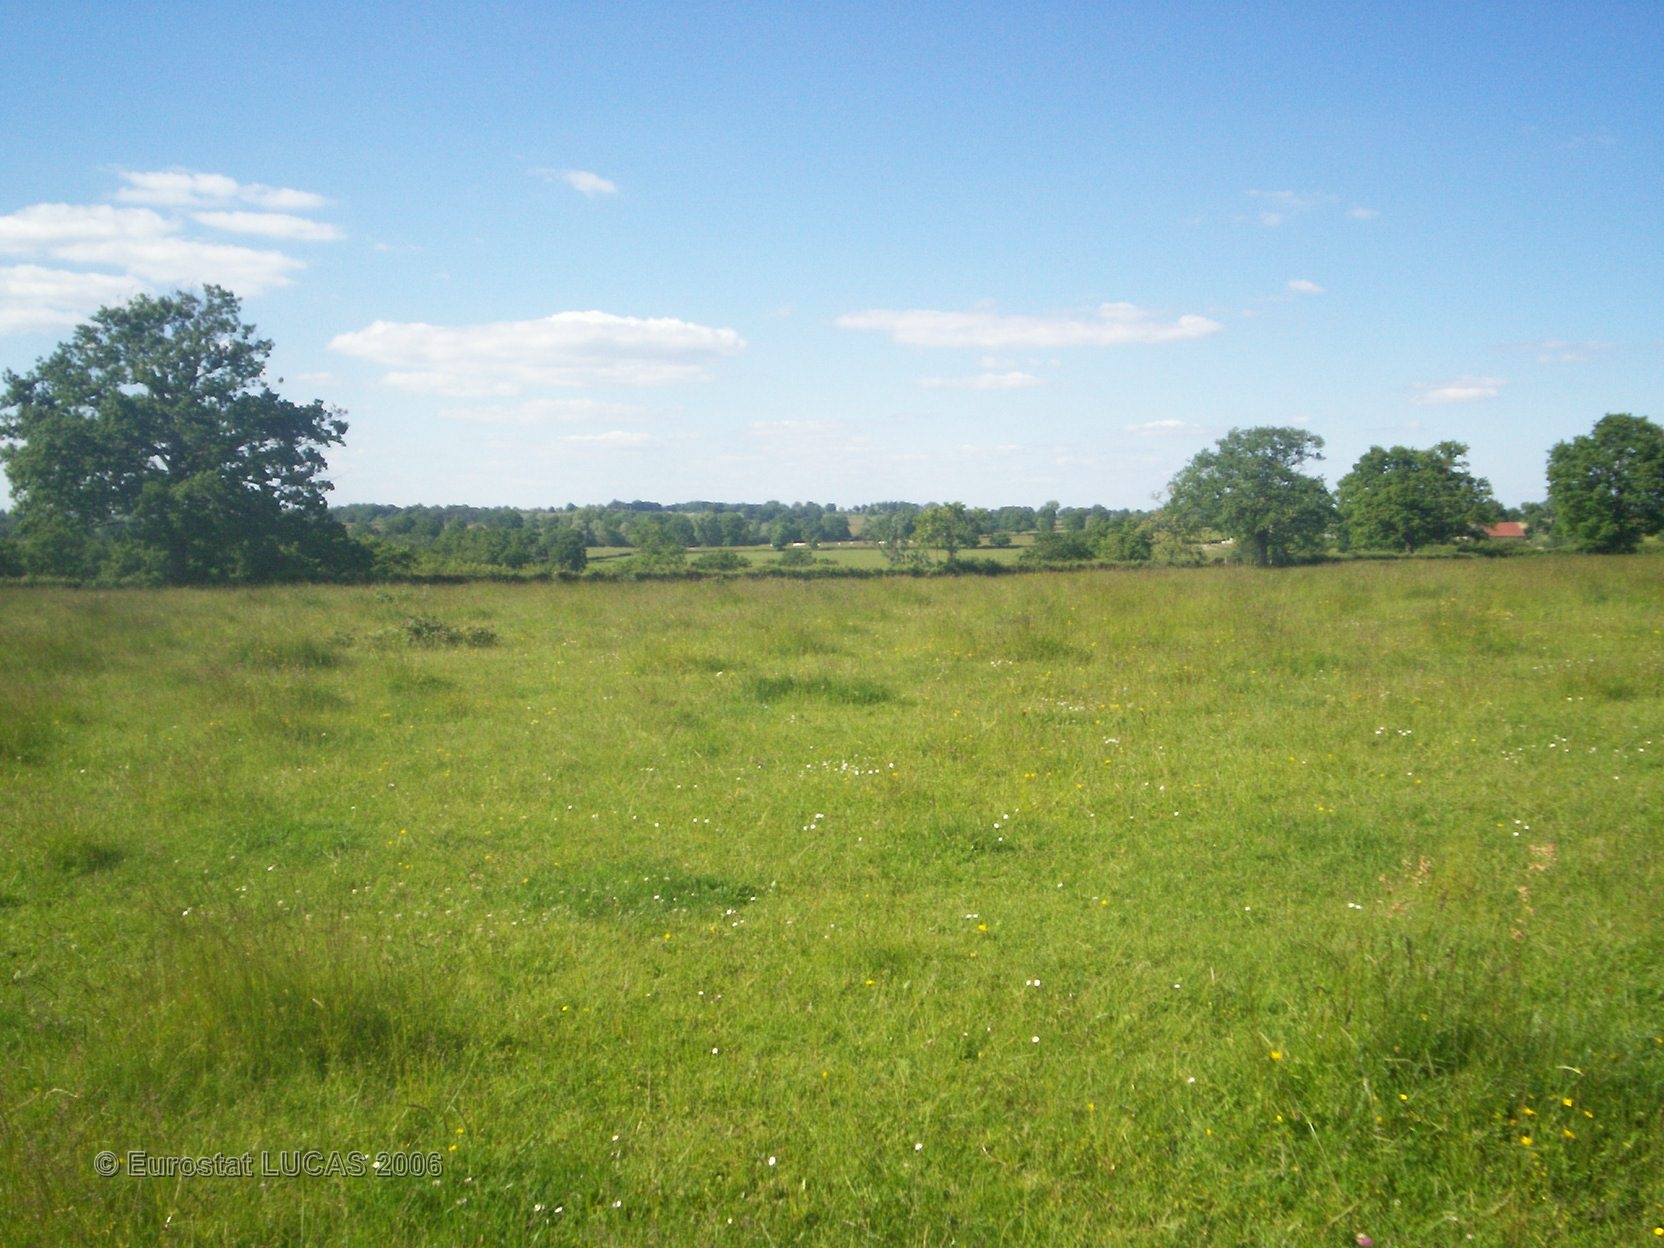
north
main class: Grassland
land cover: Grassland with sparse tree/shrub cover
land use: Agriculture (excluding fallow land and kitchen gardens)
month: June
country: FR
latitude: 46.2963
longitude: 3.1829
